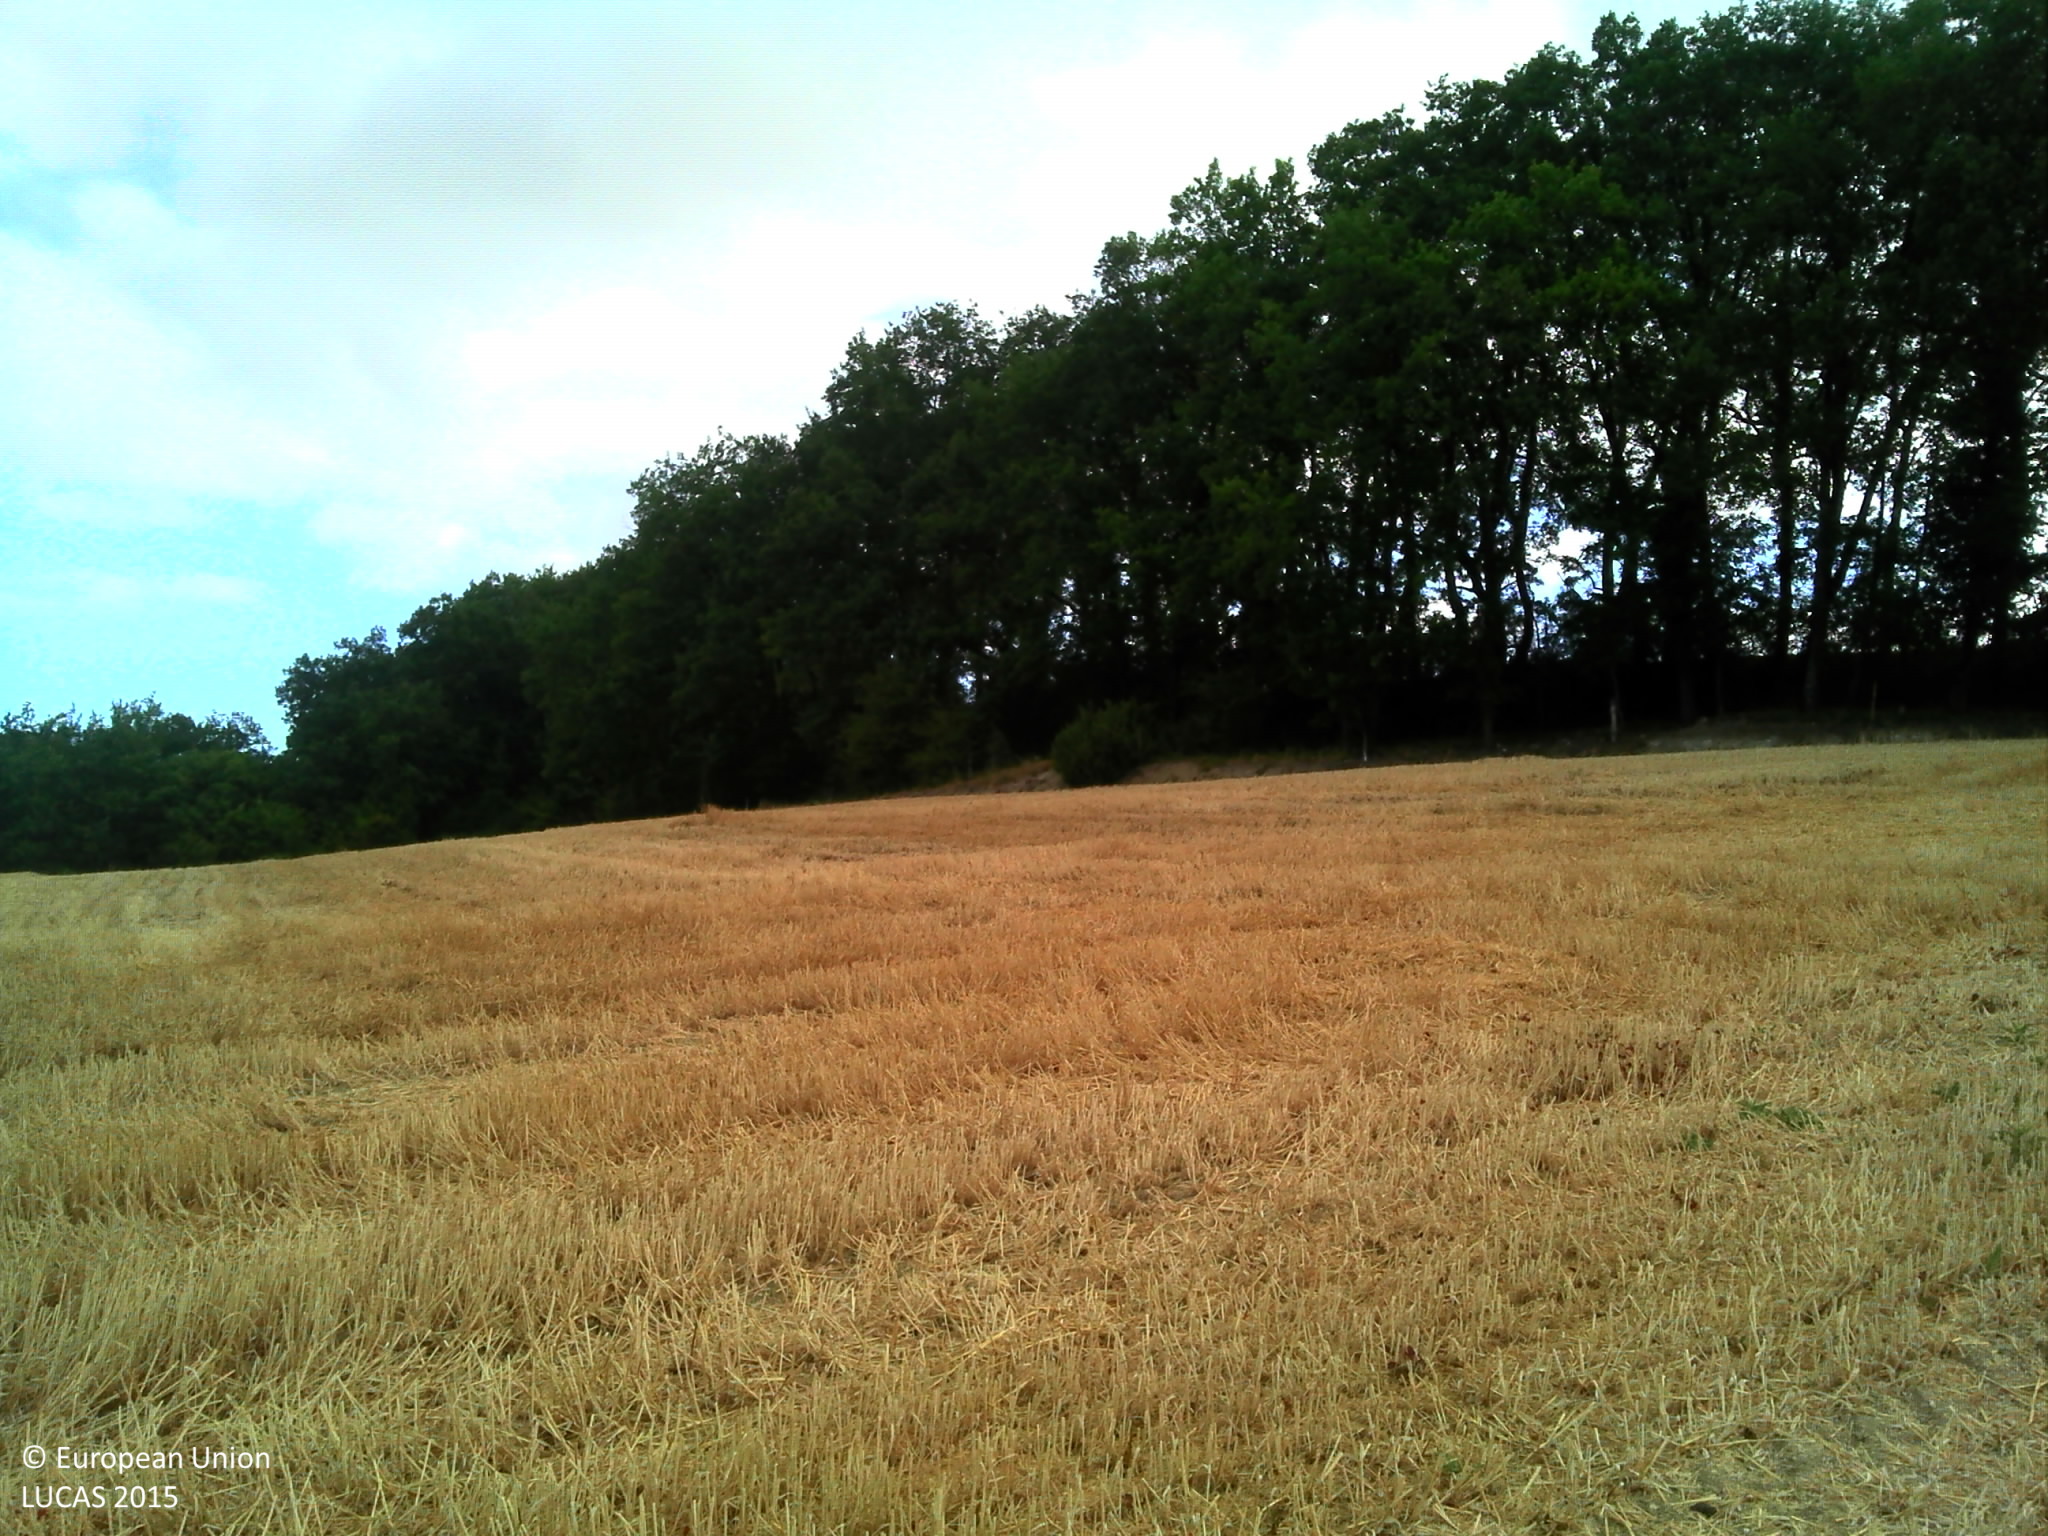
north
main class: Cropland
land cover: Common wheat
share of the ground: > 75 %
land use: Agriculture (excluding fallow land and kitchen gardens)
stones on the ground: < 10 %
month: July
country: FR
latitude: 44.3225
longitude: 0.6022
